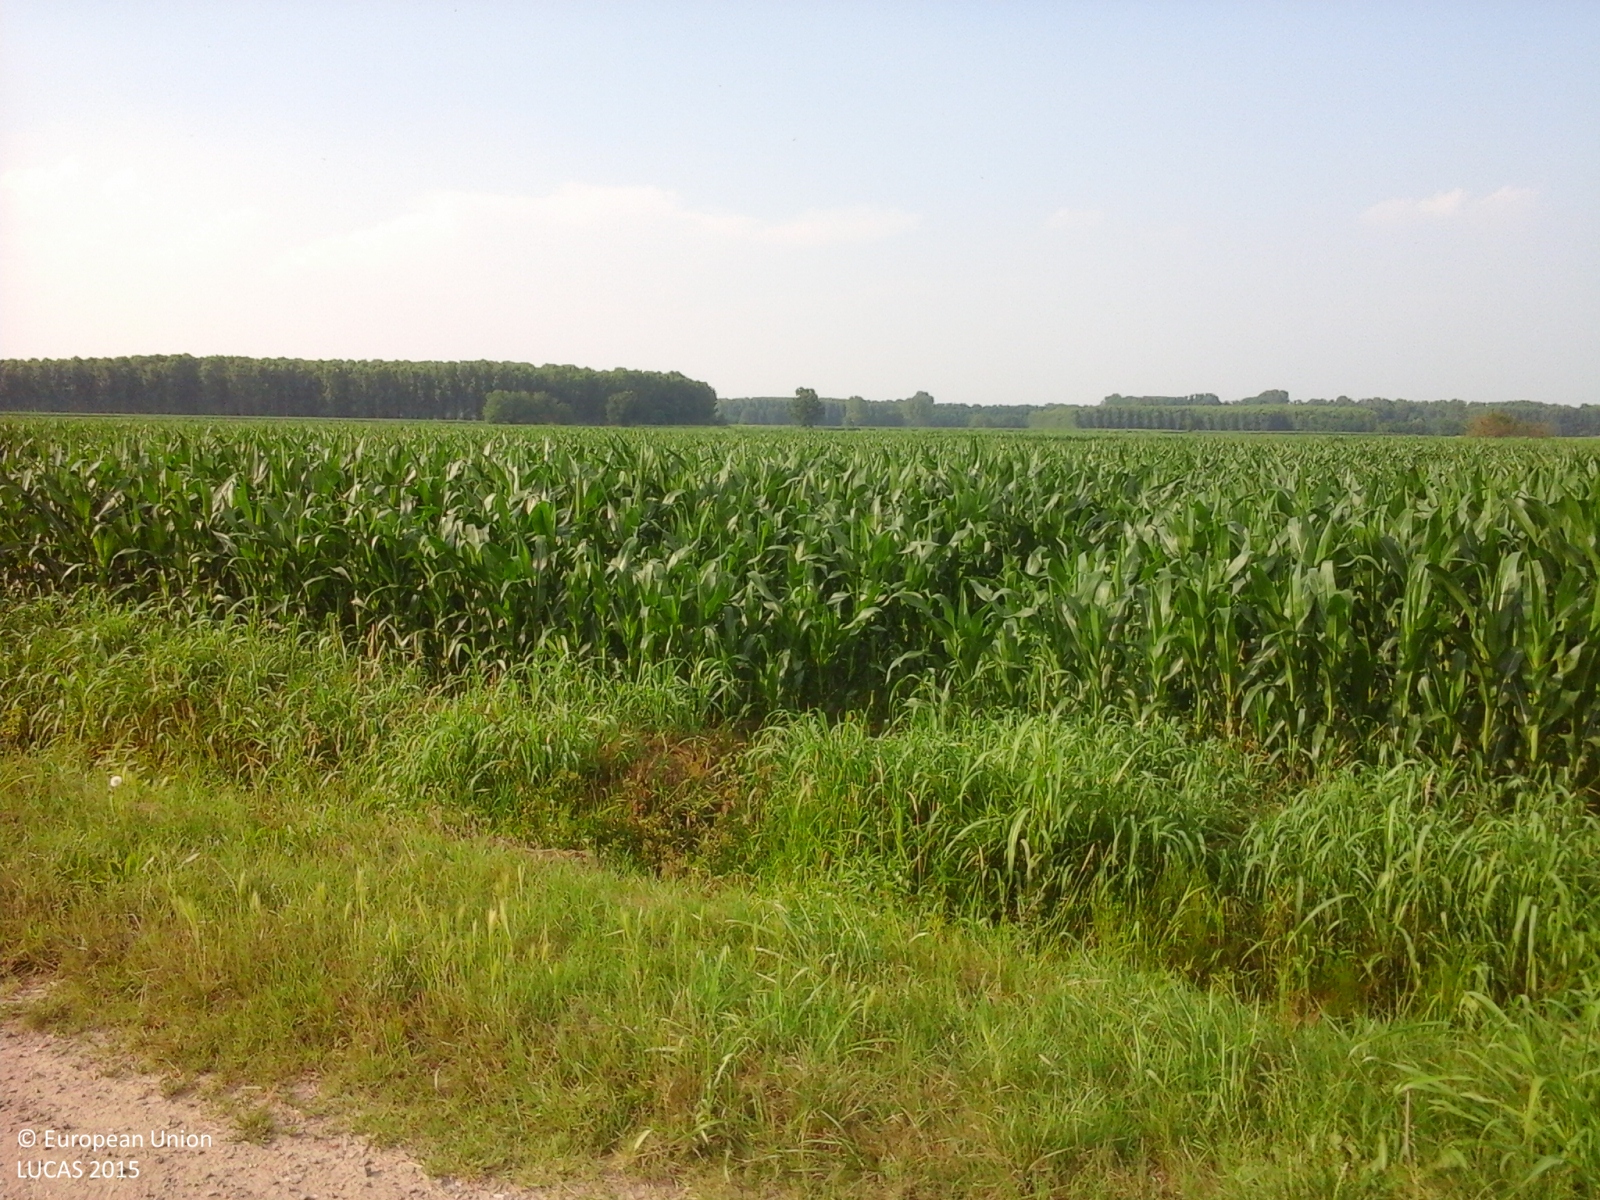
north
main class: Cropland
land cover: Rice
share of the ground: > 75 %
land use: Agriculture (excluding fallow land and kitchen gardens)
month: June
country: IT
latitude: 45.1422
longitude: 9.4034
